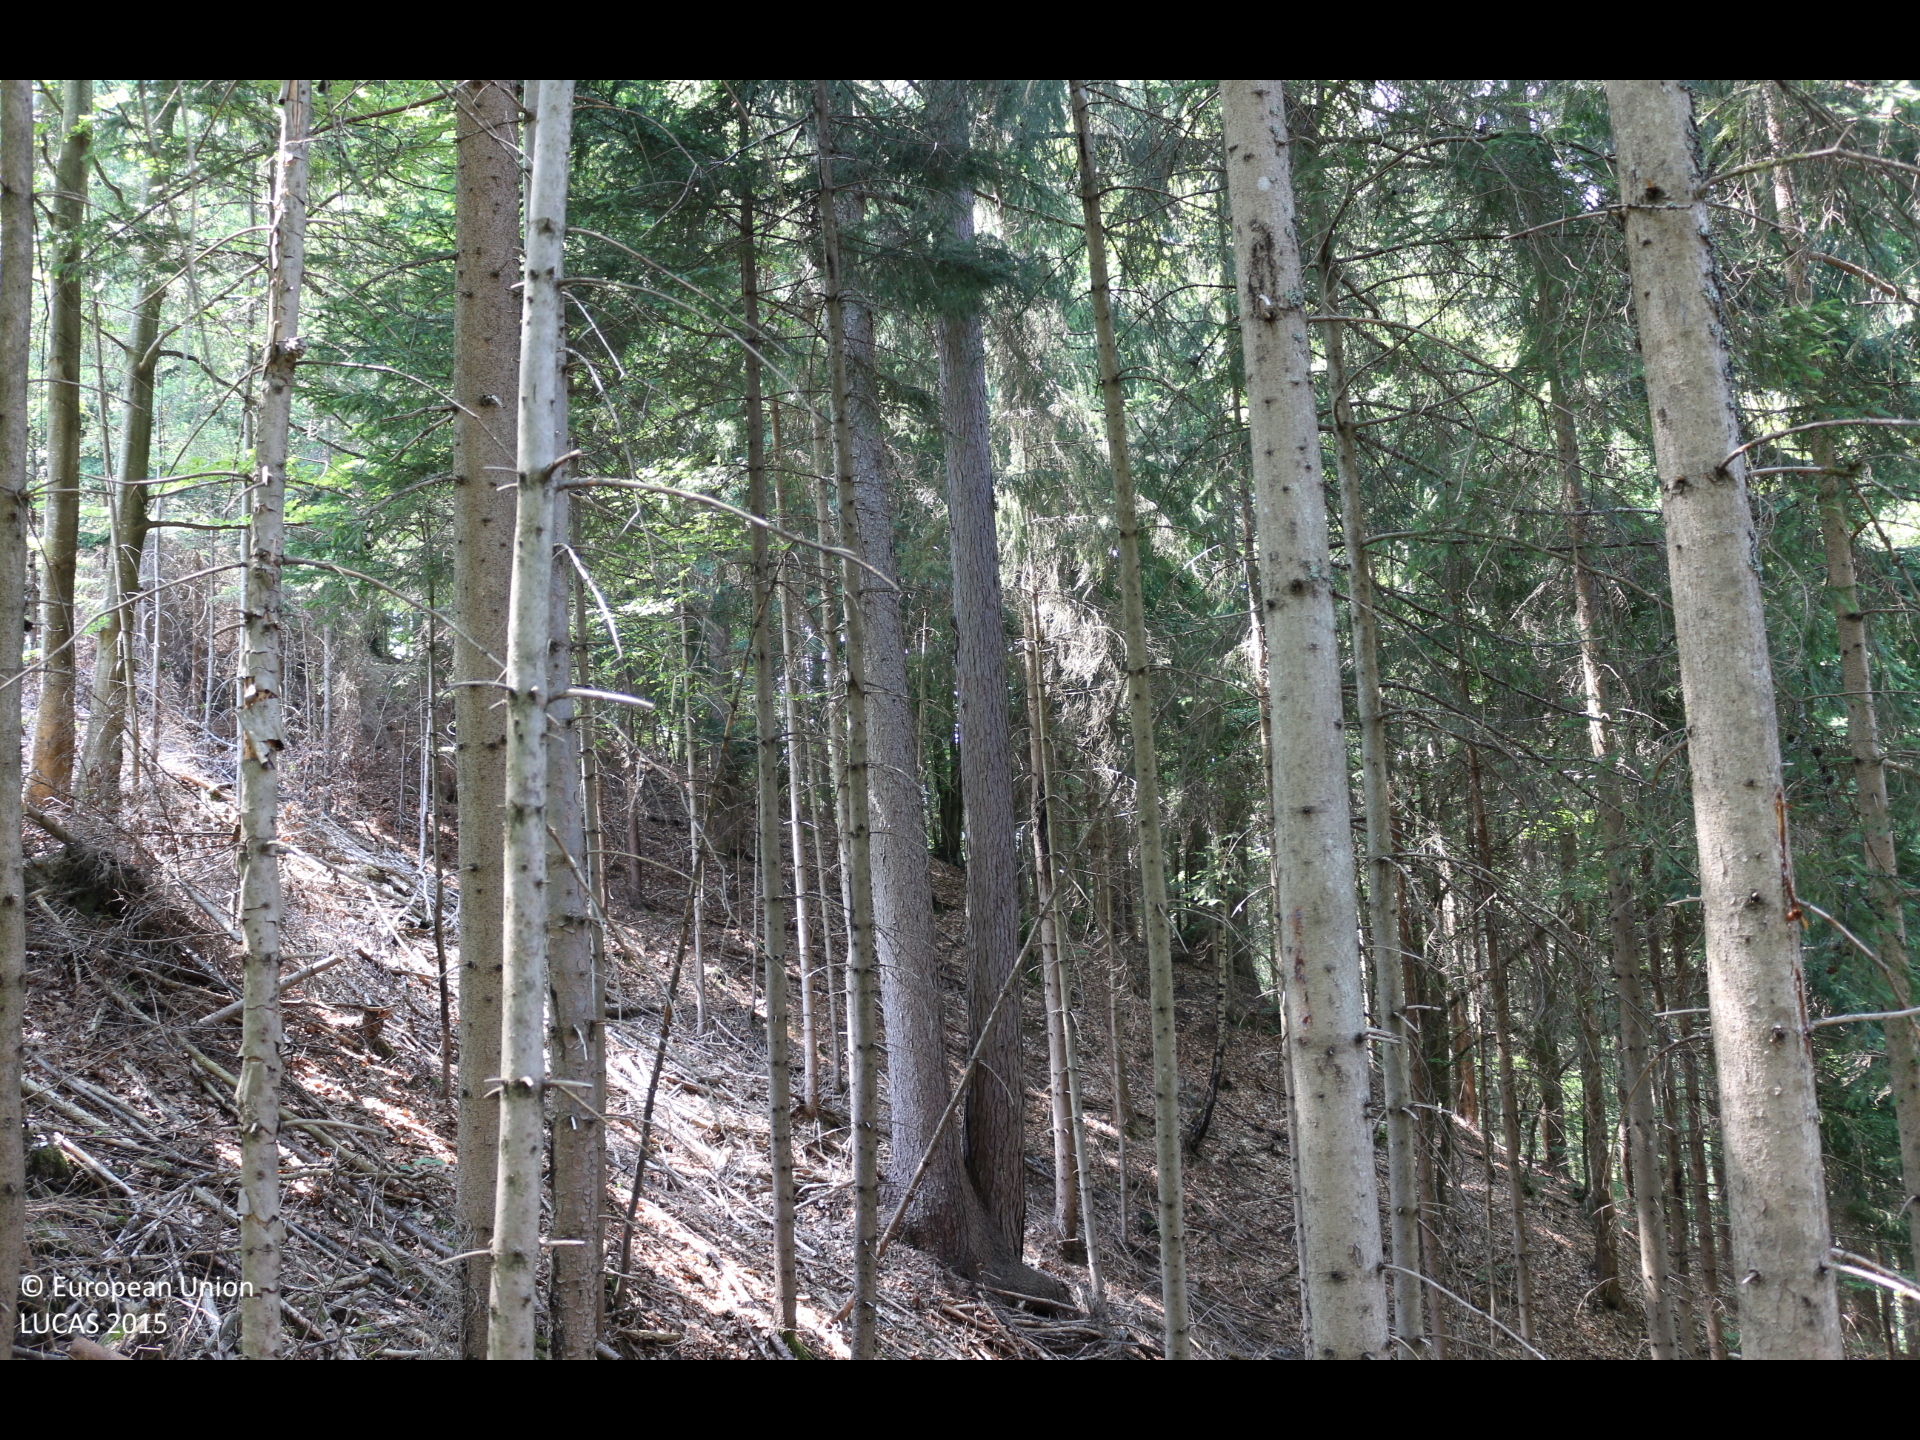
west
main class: Woodland
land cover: Spruce dominated coniferous woodland
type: alpine coniferous forest
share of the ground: > 75 %
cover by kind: coniferous forest trees 90 %, broadleaved forest trees 10 %
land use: Forestry
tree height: > 5 m
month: June
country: AT
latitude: 46.5478
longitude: 13.9749
